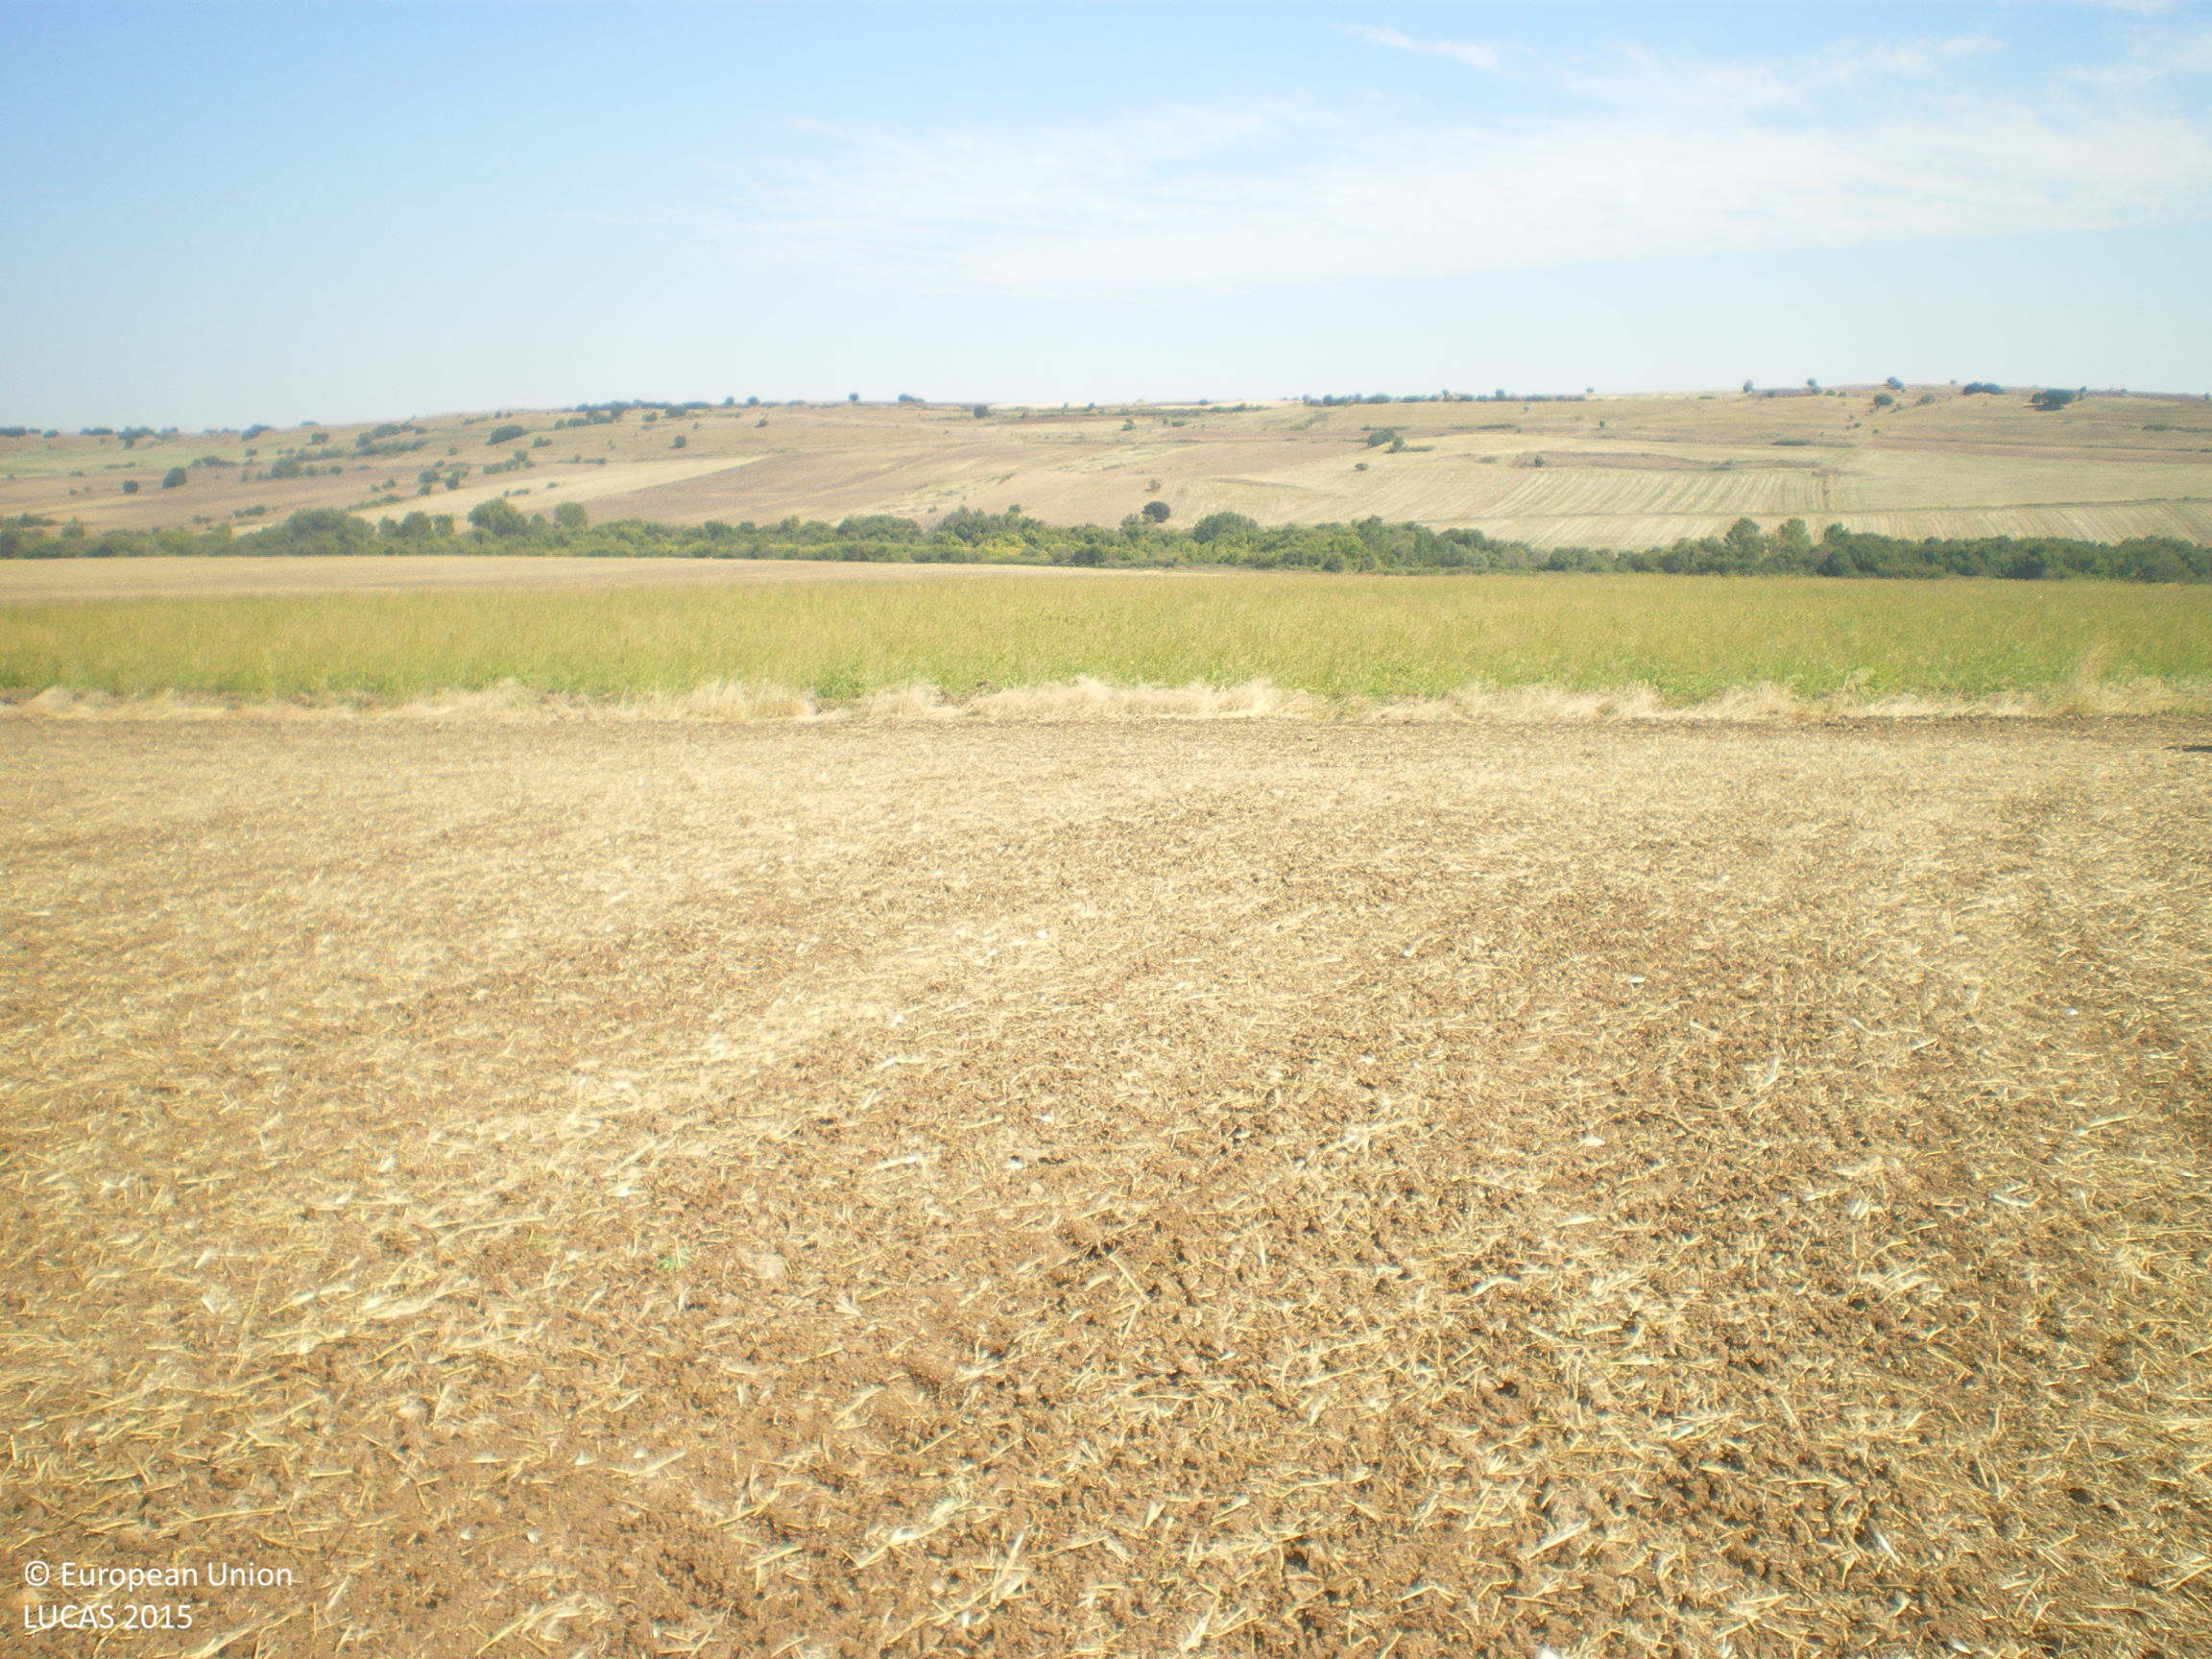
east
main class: Cropland
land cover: Common wheat
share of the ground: < 10 %
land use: Agriculture (excluding fallow land and kitchen gardens)
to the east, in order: Common wheat; Spontaneously vegetated surfaces; Common wheat
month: September
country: BG
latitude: 41.7775
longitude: 26.3327
